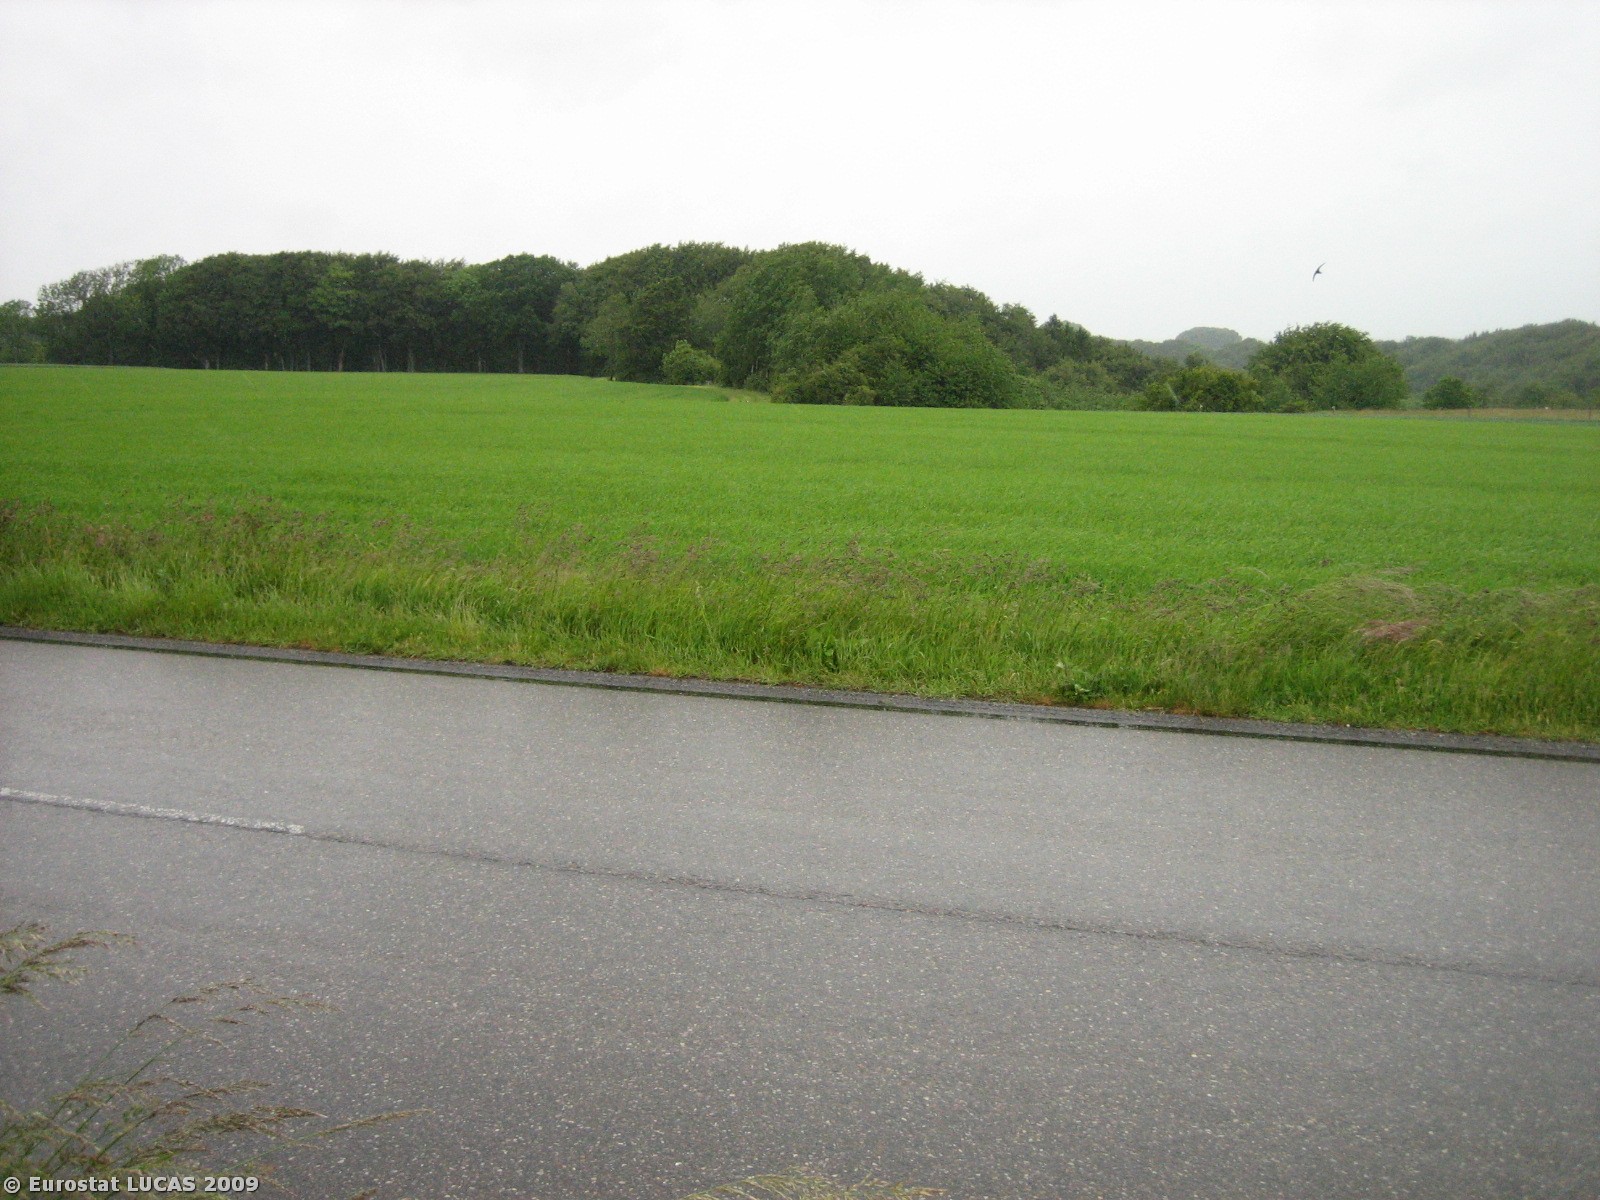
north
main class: Cropland
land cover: Rape and turnip rape
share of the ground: > 75 %
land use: Agriculture (excluding fallow land and kitchen gardens)
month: June
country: DK
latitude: 56.0979
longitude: 10.0161
